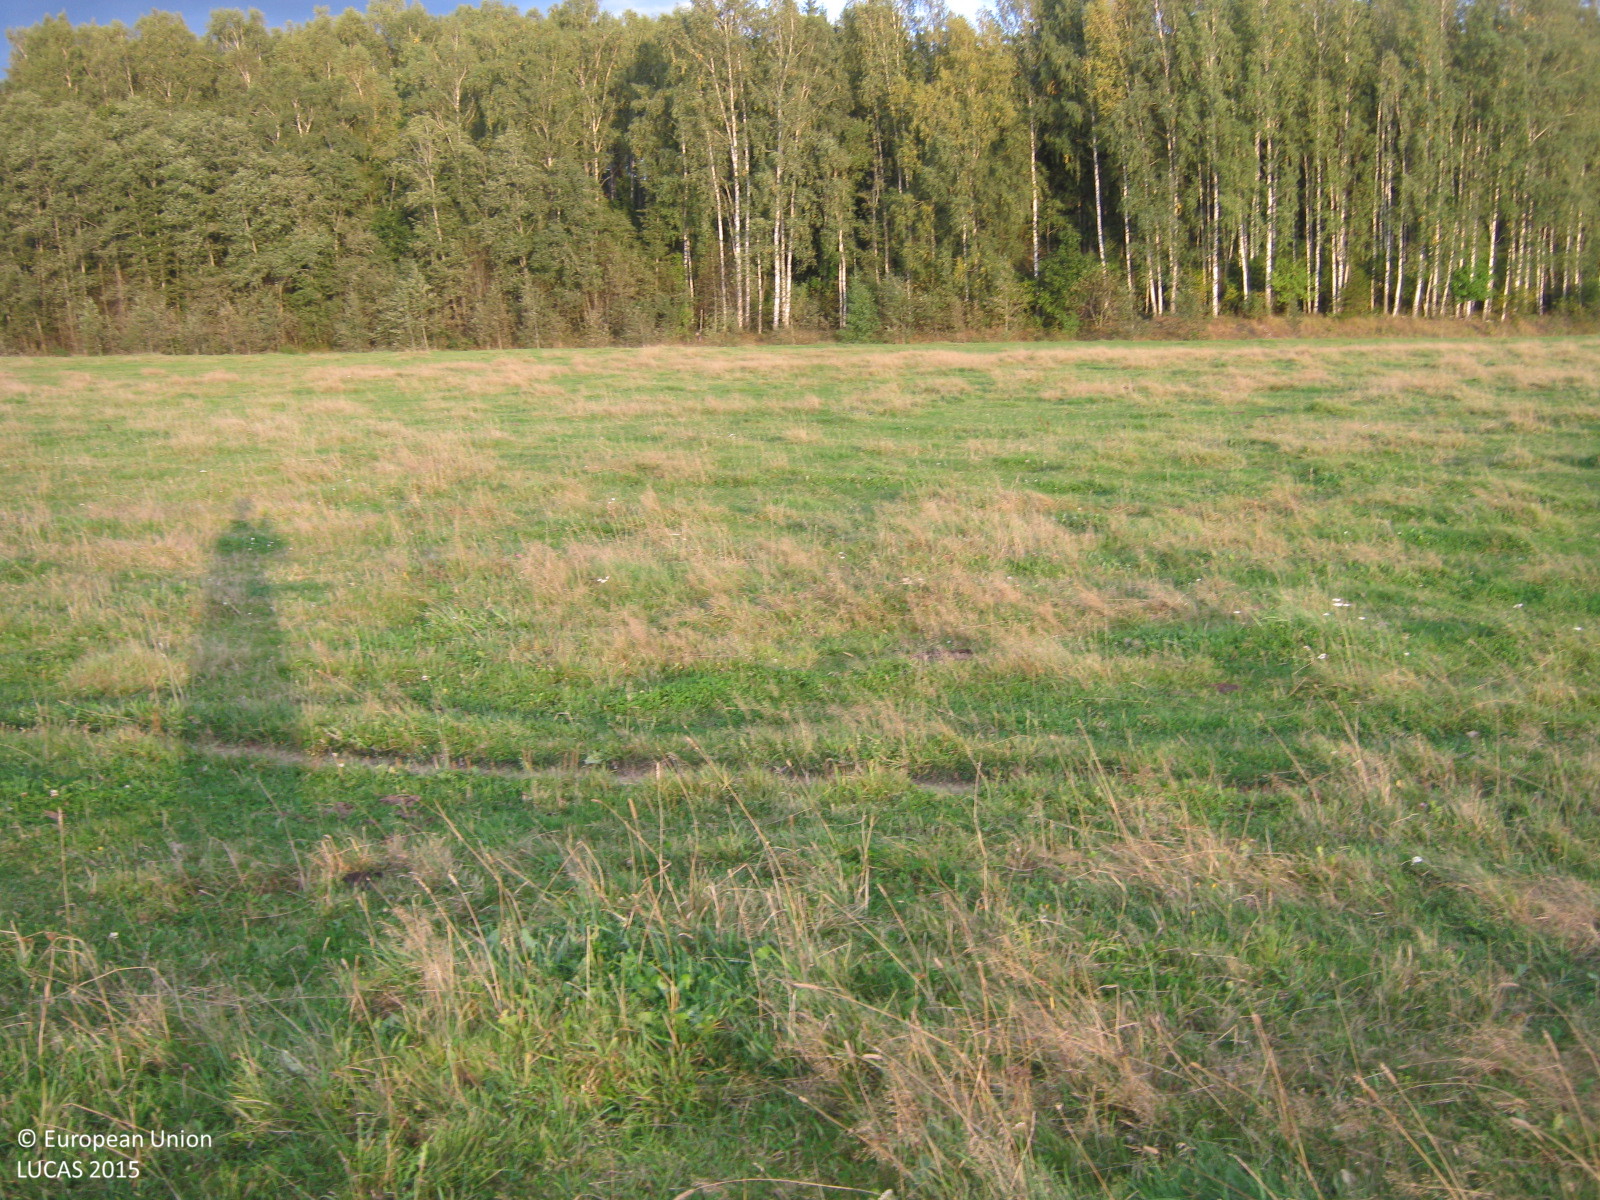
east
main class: Grassland
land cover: Grassland without tree/shrub cover
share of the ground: > 75 %
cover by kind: herbaceous plants 95 %
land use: Agriculture (excluding fallow land and kitchen gardens)
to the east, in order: Grassland without tree/shrub cover; Ditches and canals; Broadleaved woodland; Spruce dominated mixed woodland
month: September
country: LV
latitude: 57.3806
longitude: 24.7510
